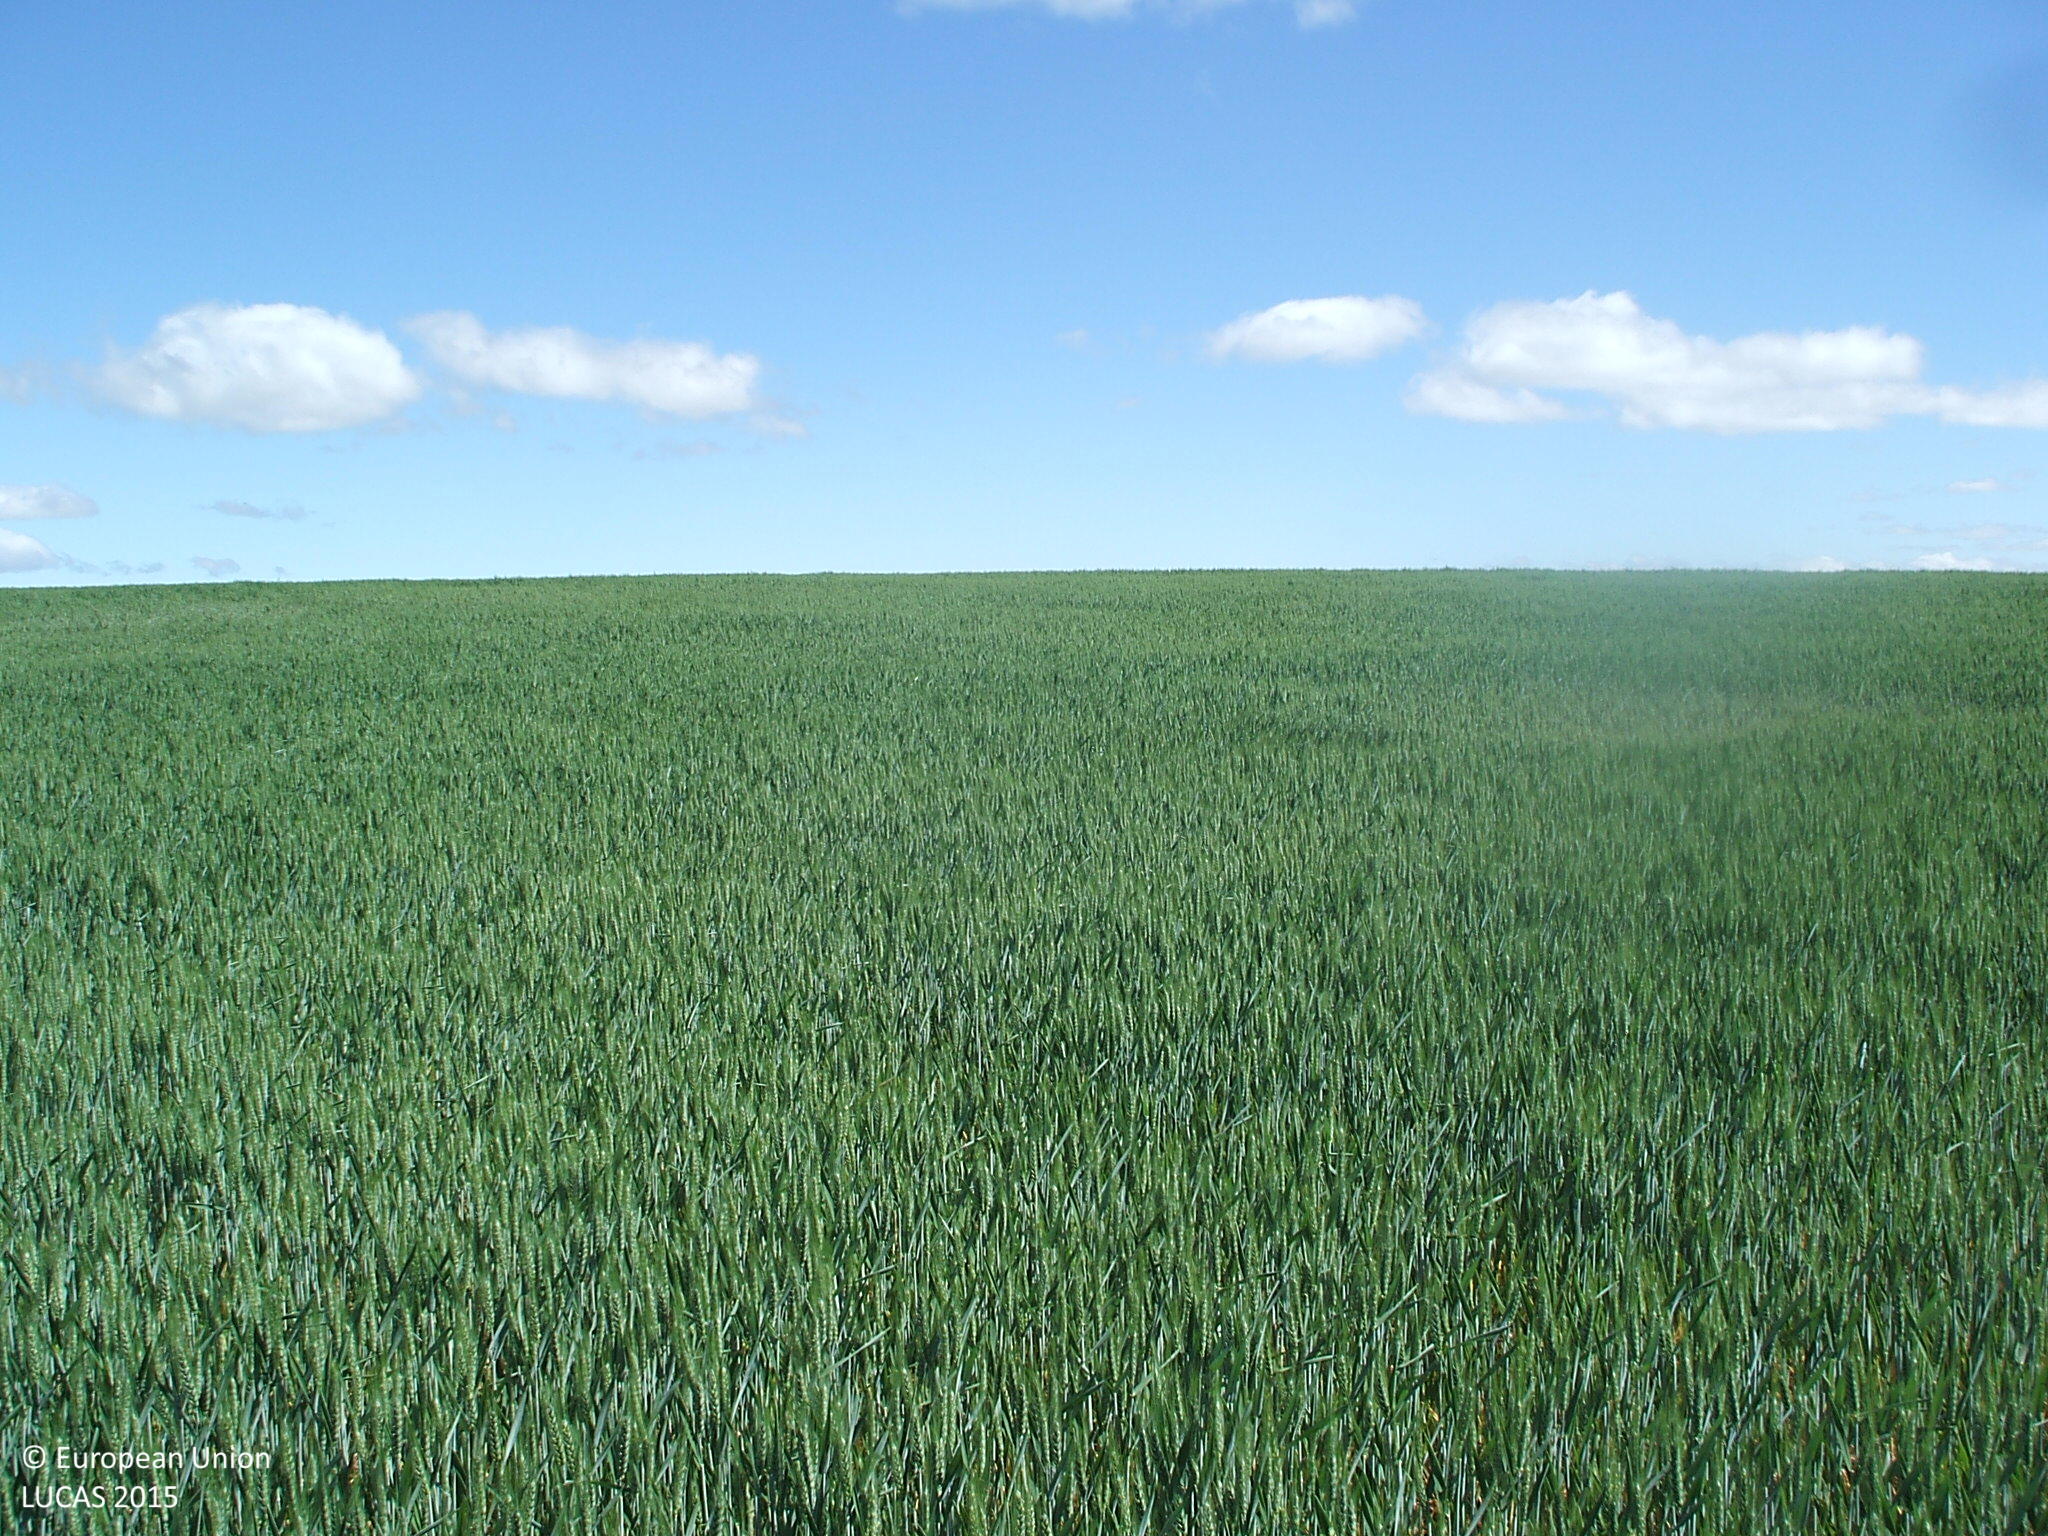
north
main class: Cropland
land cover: Common wheat
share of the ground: > 75 %
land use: Agriculture (excluding fallow land and kitchen gardens)
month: May
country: ES
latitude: 40.8771
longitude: -2.8844
